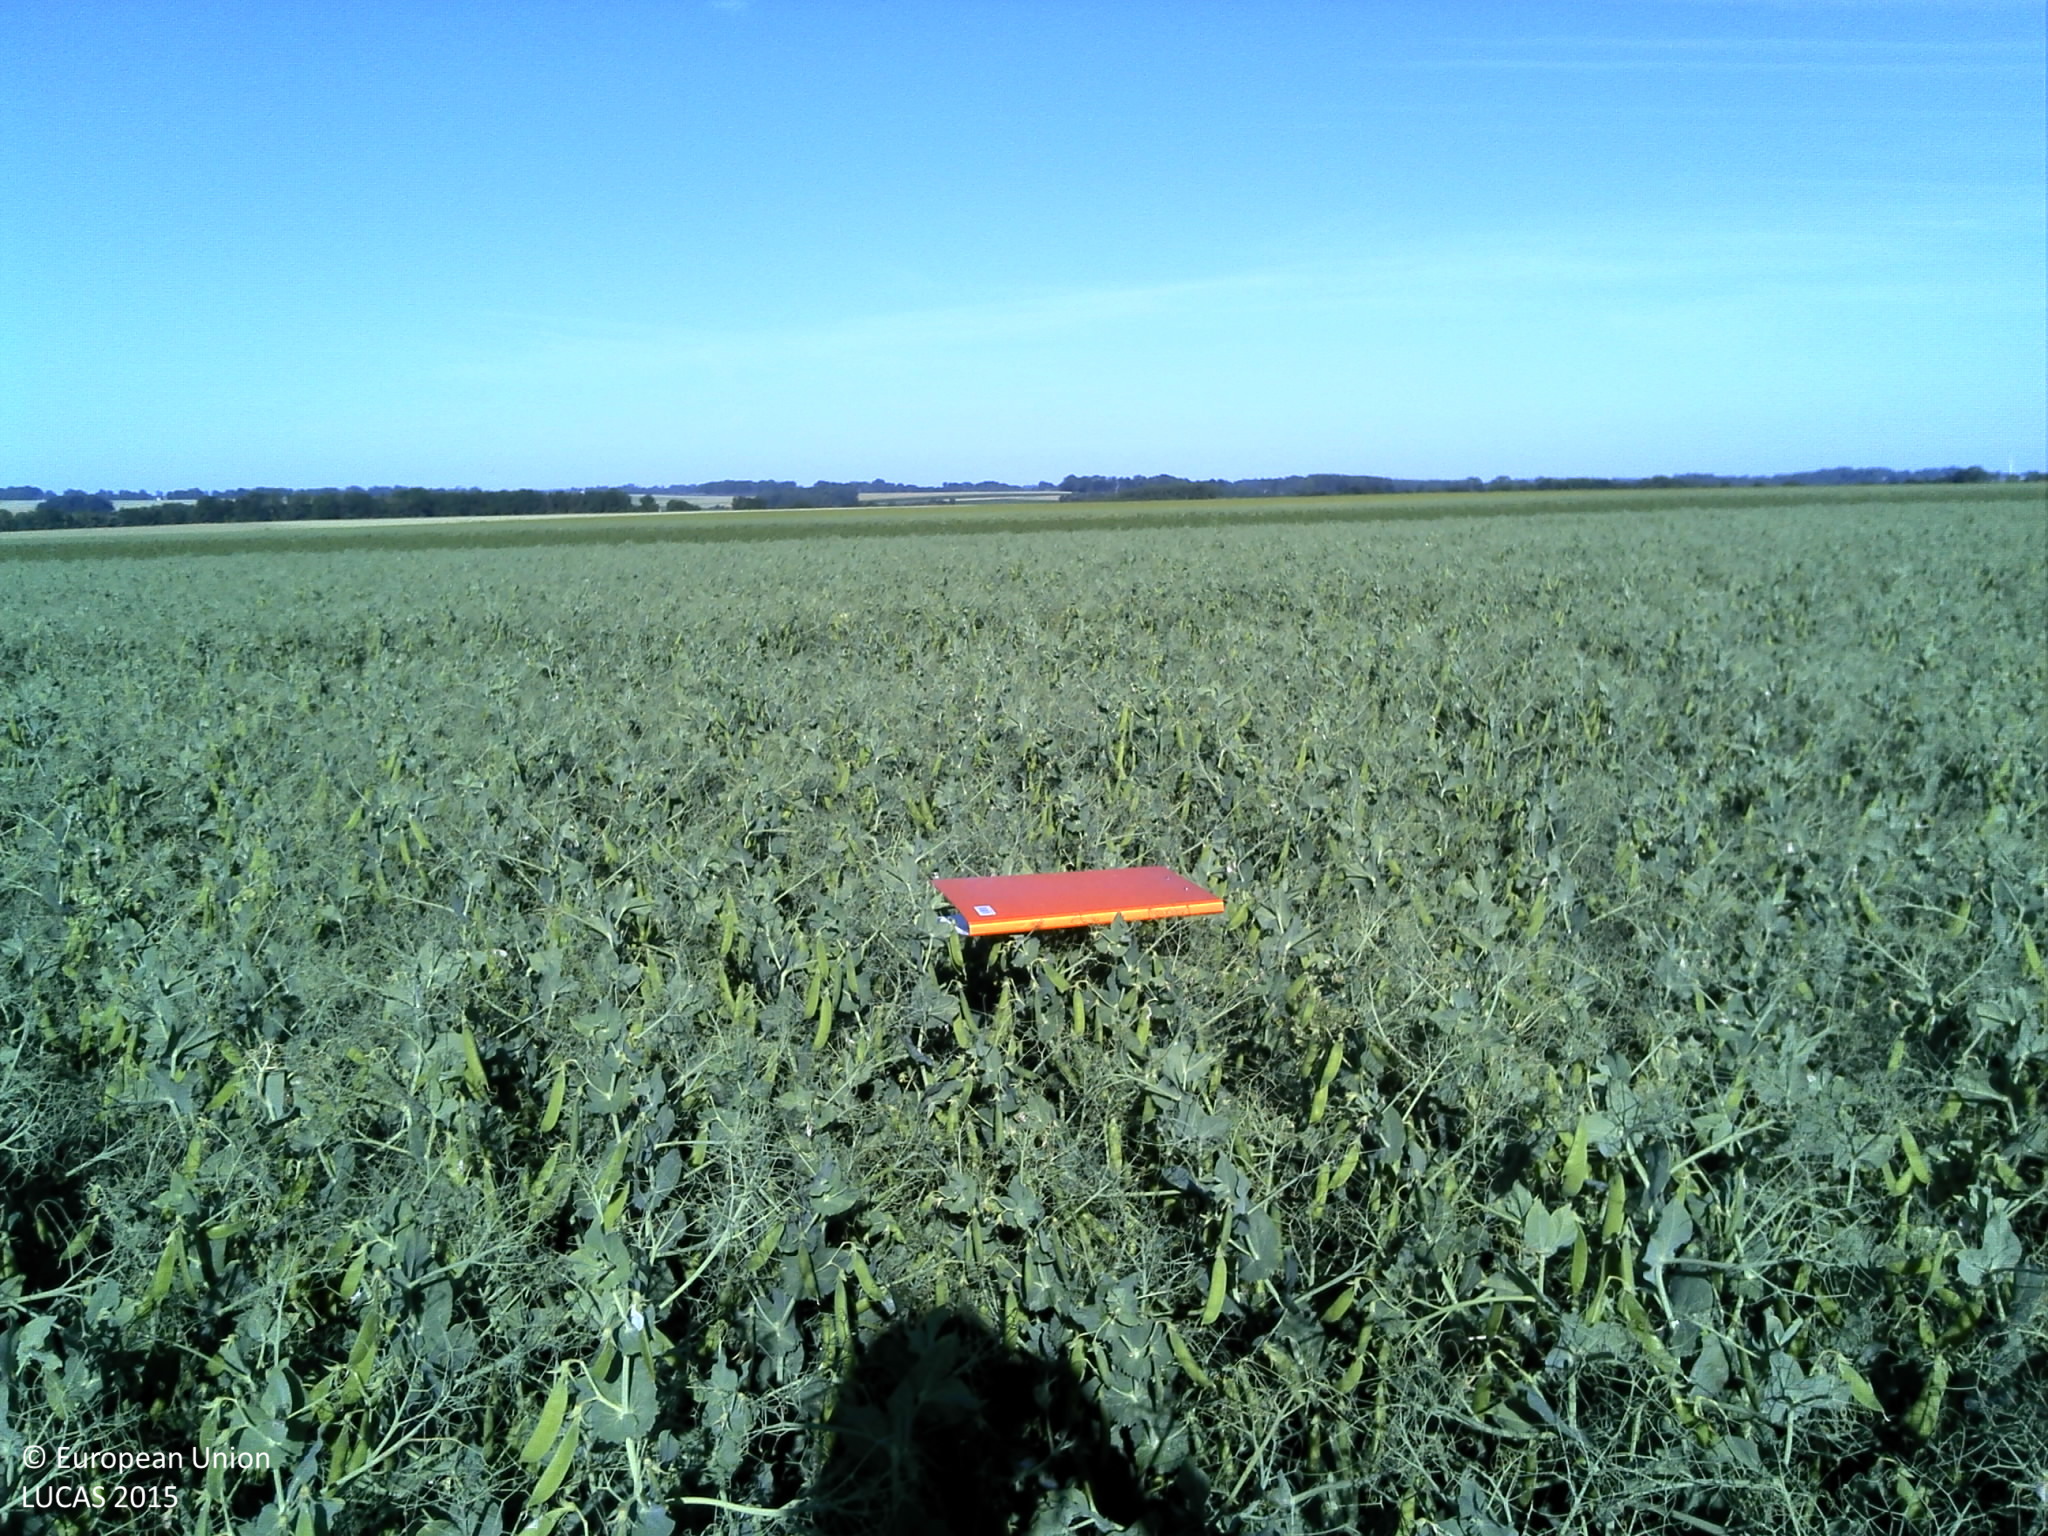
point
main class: Cropland
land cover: Dry pulses
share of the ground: > 75 %
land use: Agriculture (excluding fallow land and kitchen gardens)
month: June
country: FR
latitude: 49.7751
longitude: 1.0209
